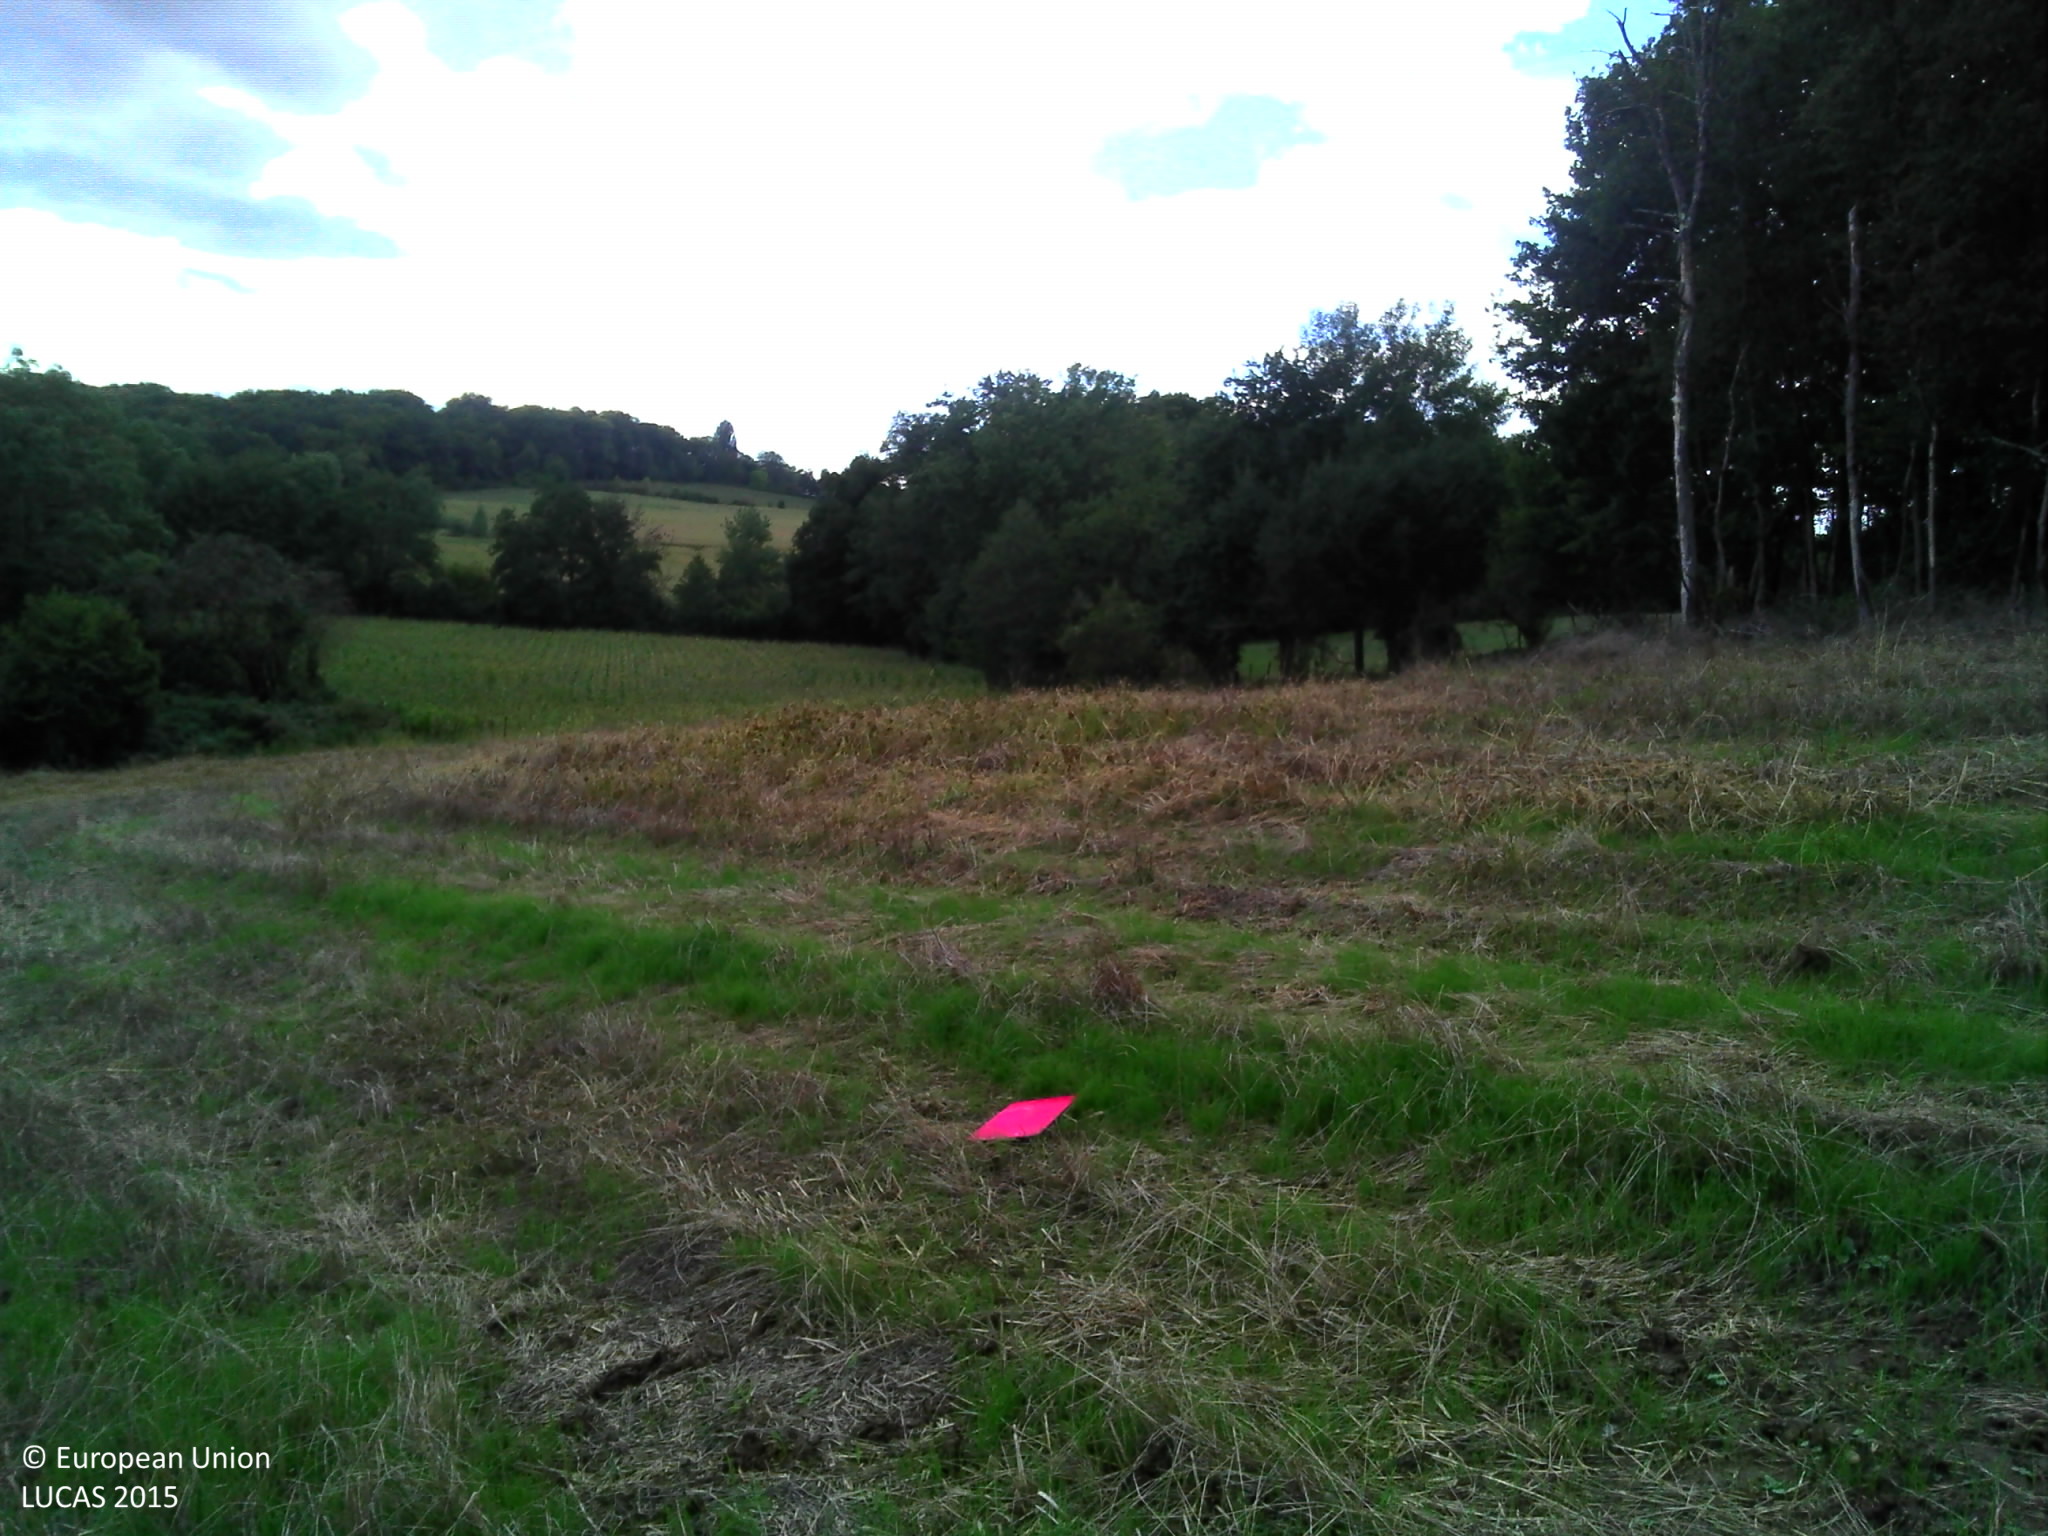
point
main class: Cropland
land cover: Barley
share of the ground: 50 - 75 %
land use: Agriculture (excluding fallow land and kitchen gardens)
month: September
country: FR
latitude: 43.4146
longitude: -0.6931
